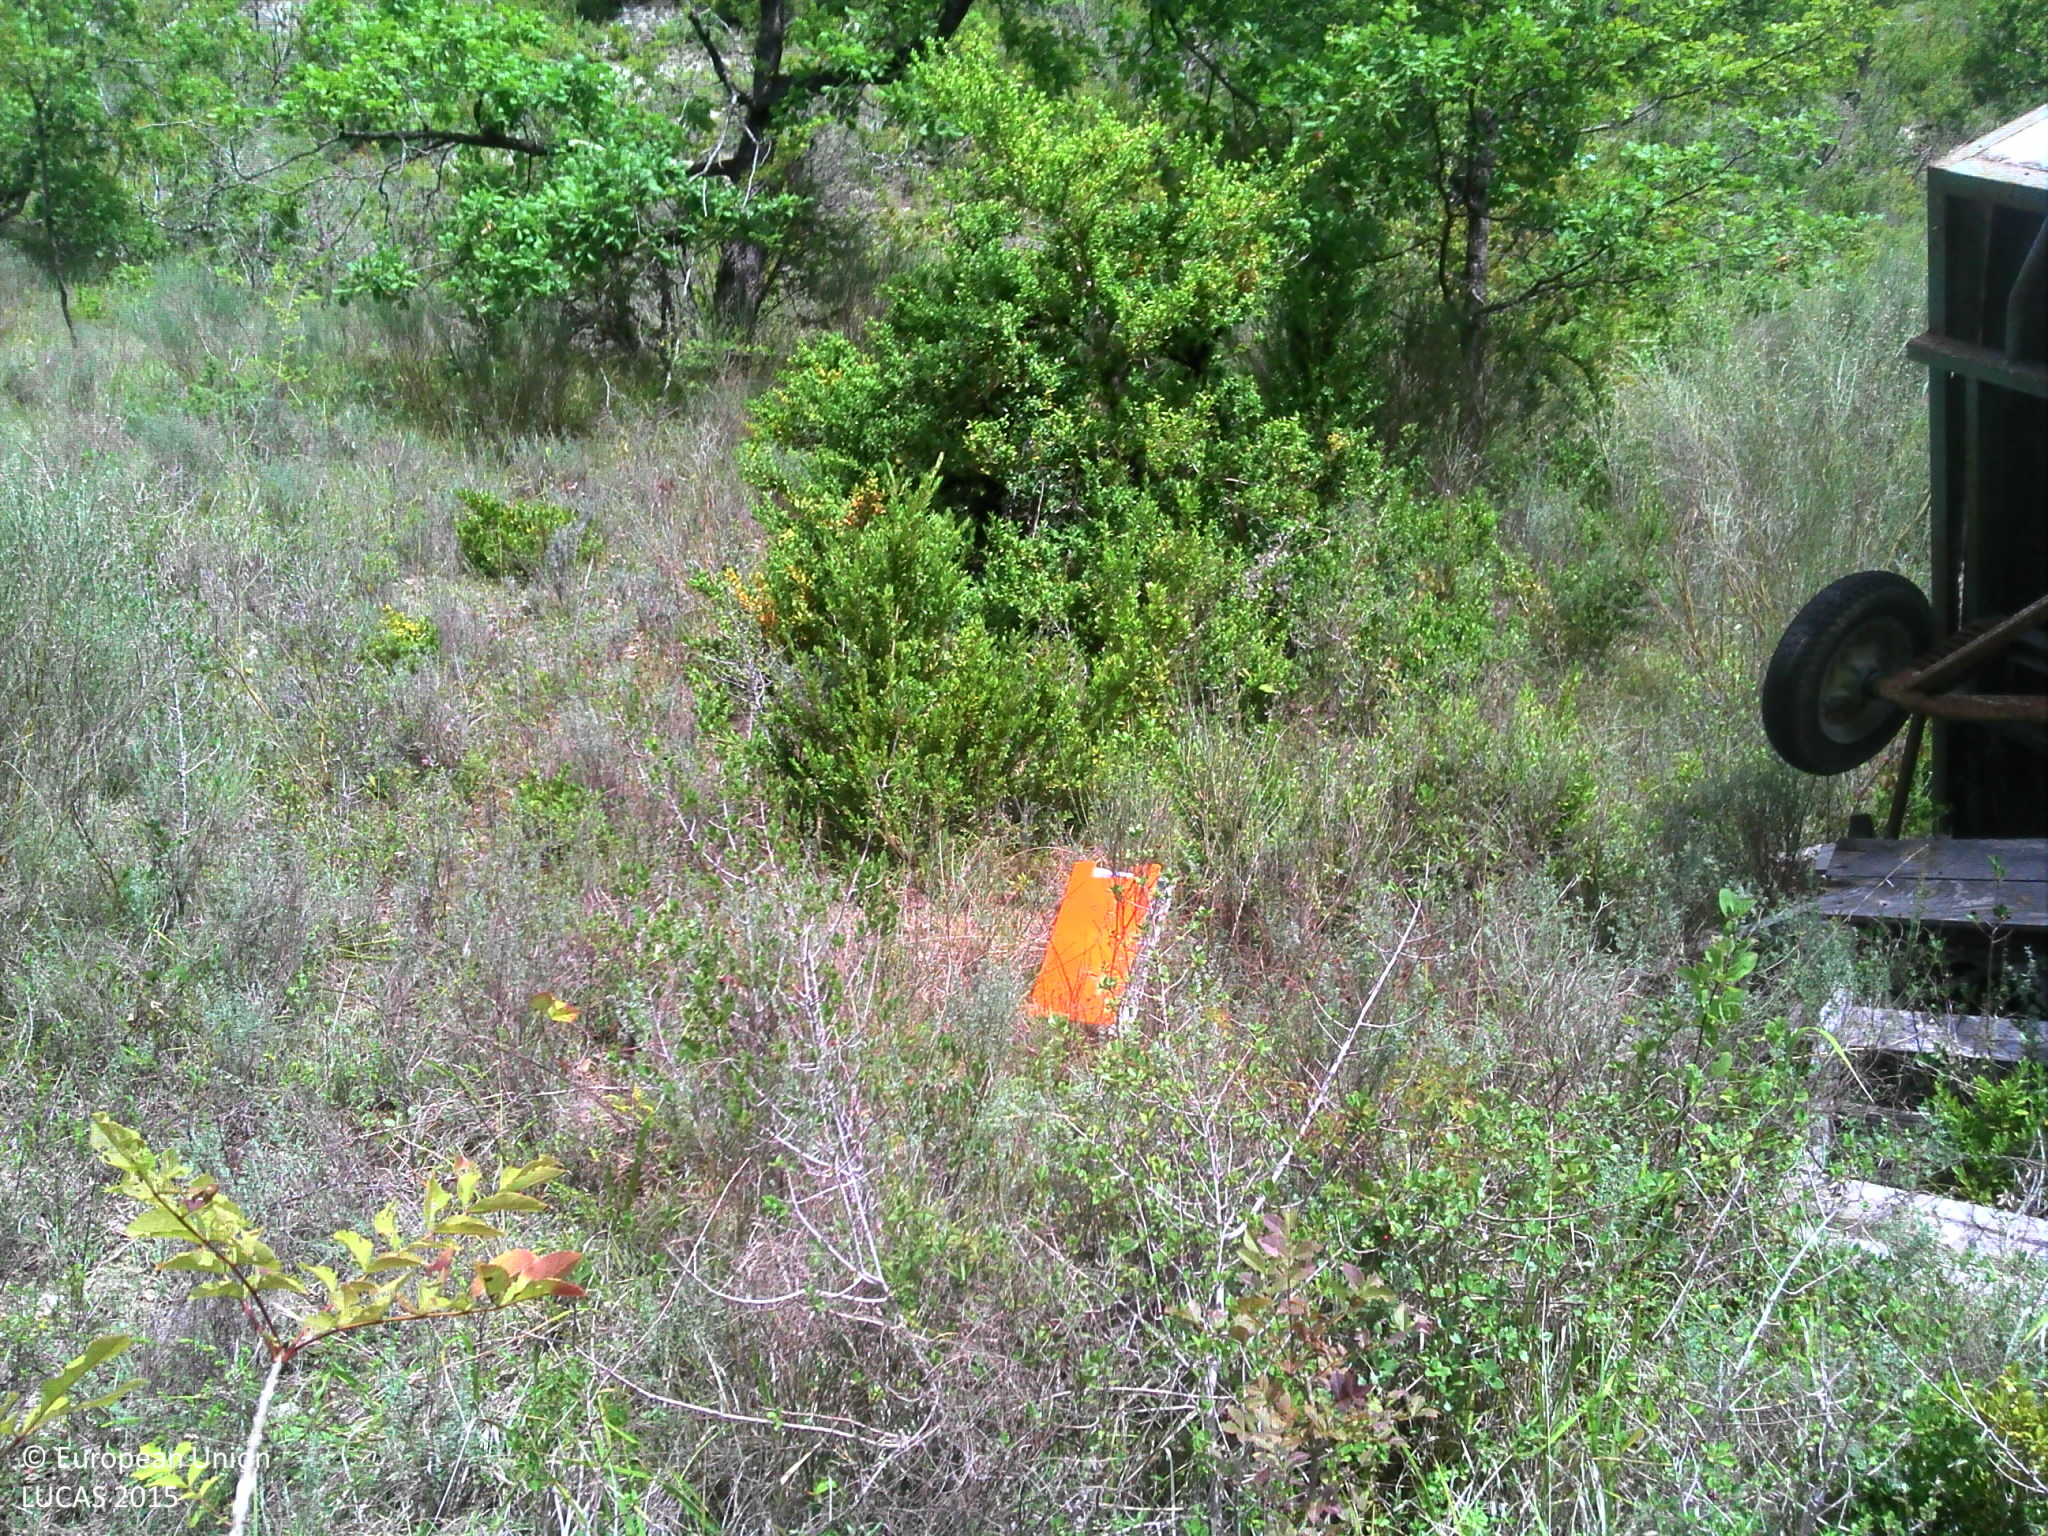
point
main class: Shrubland
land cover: Shrubland with sparse tree cover
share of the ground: > 75 %
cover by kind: shrubs 65 %, herbaceous plants 30 %, broadleaved forest trees 5 %
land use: Semi-natural and natural areas not in use
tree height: > 5 m
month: August
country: FR
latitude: 44.3476
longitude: 1.3047
